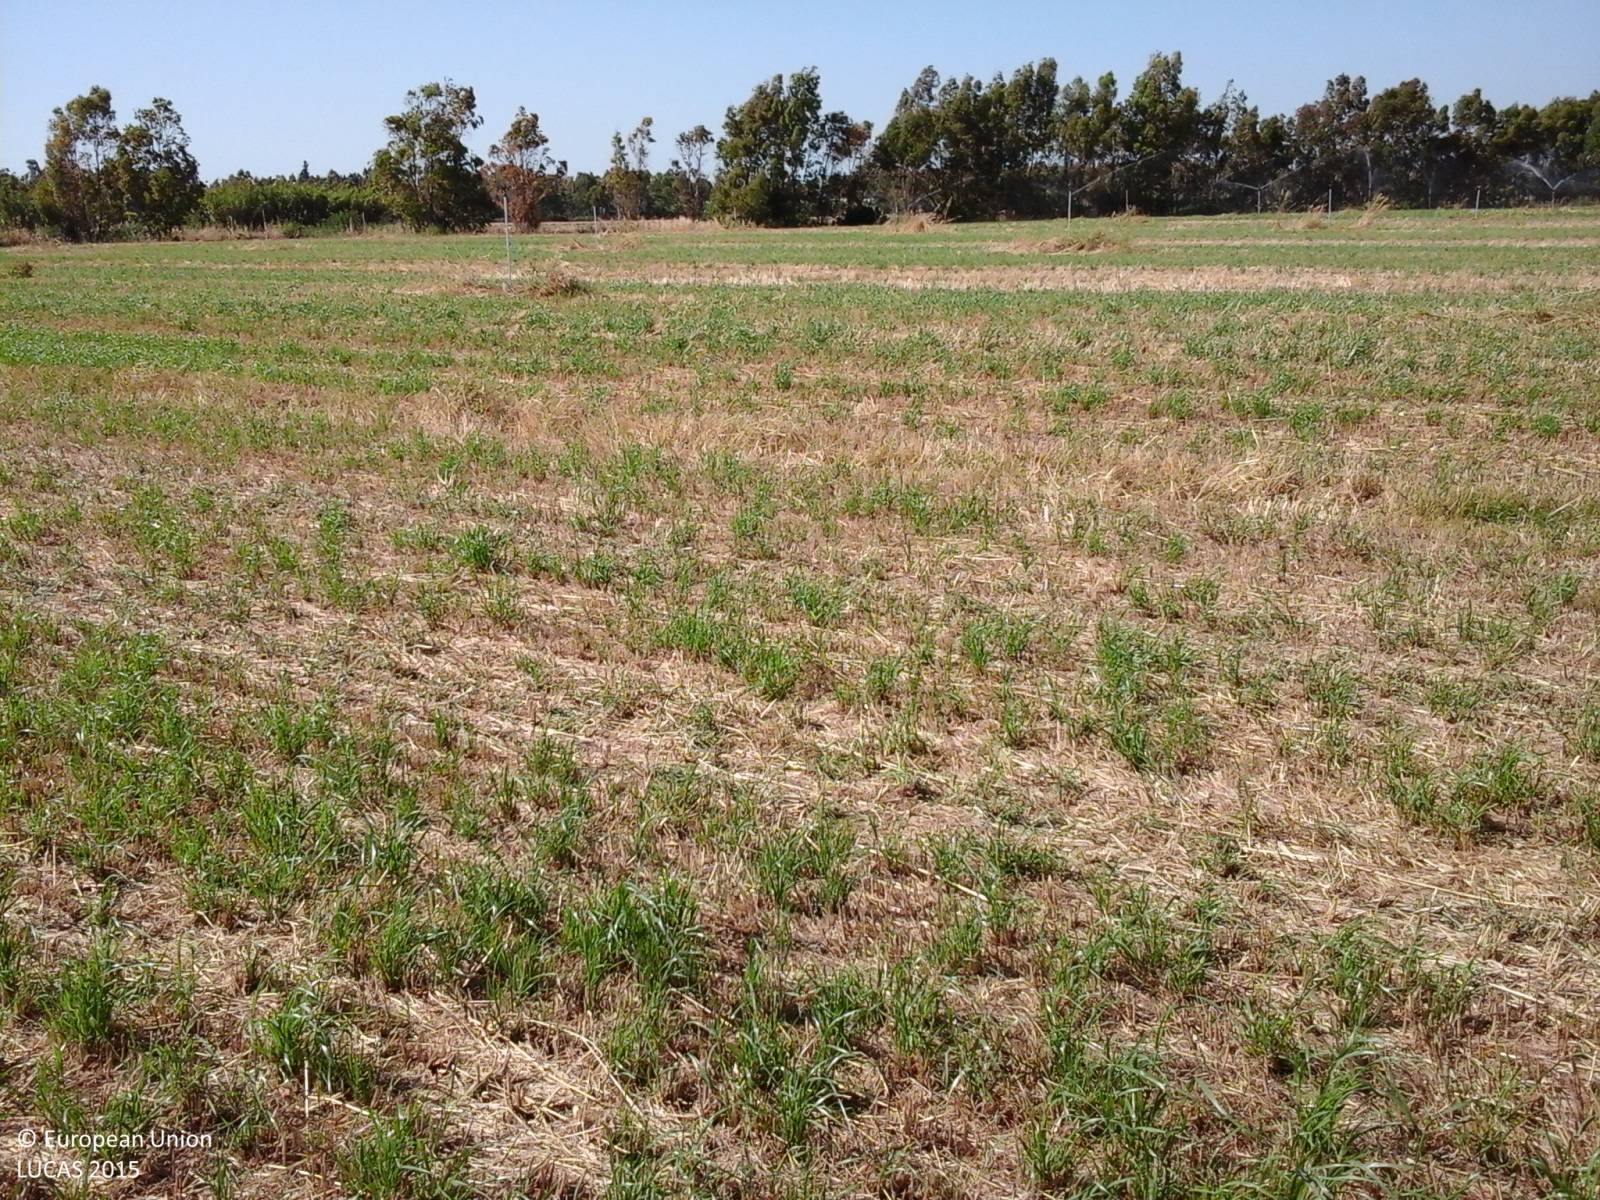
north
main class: Cropland
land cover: Temporary grasslands
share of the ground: > 75 %
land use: Agriculture (excluding fallow land and kitchen gardens)
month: May
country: IT
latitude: 39.7140
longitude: 8.5966
